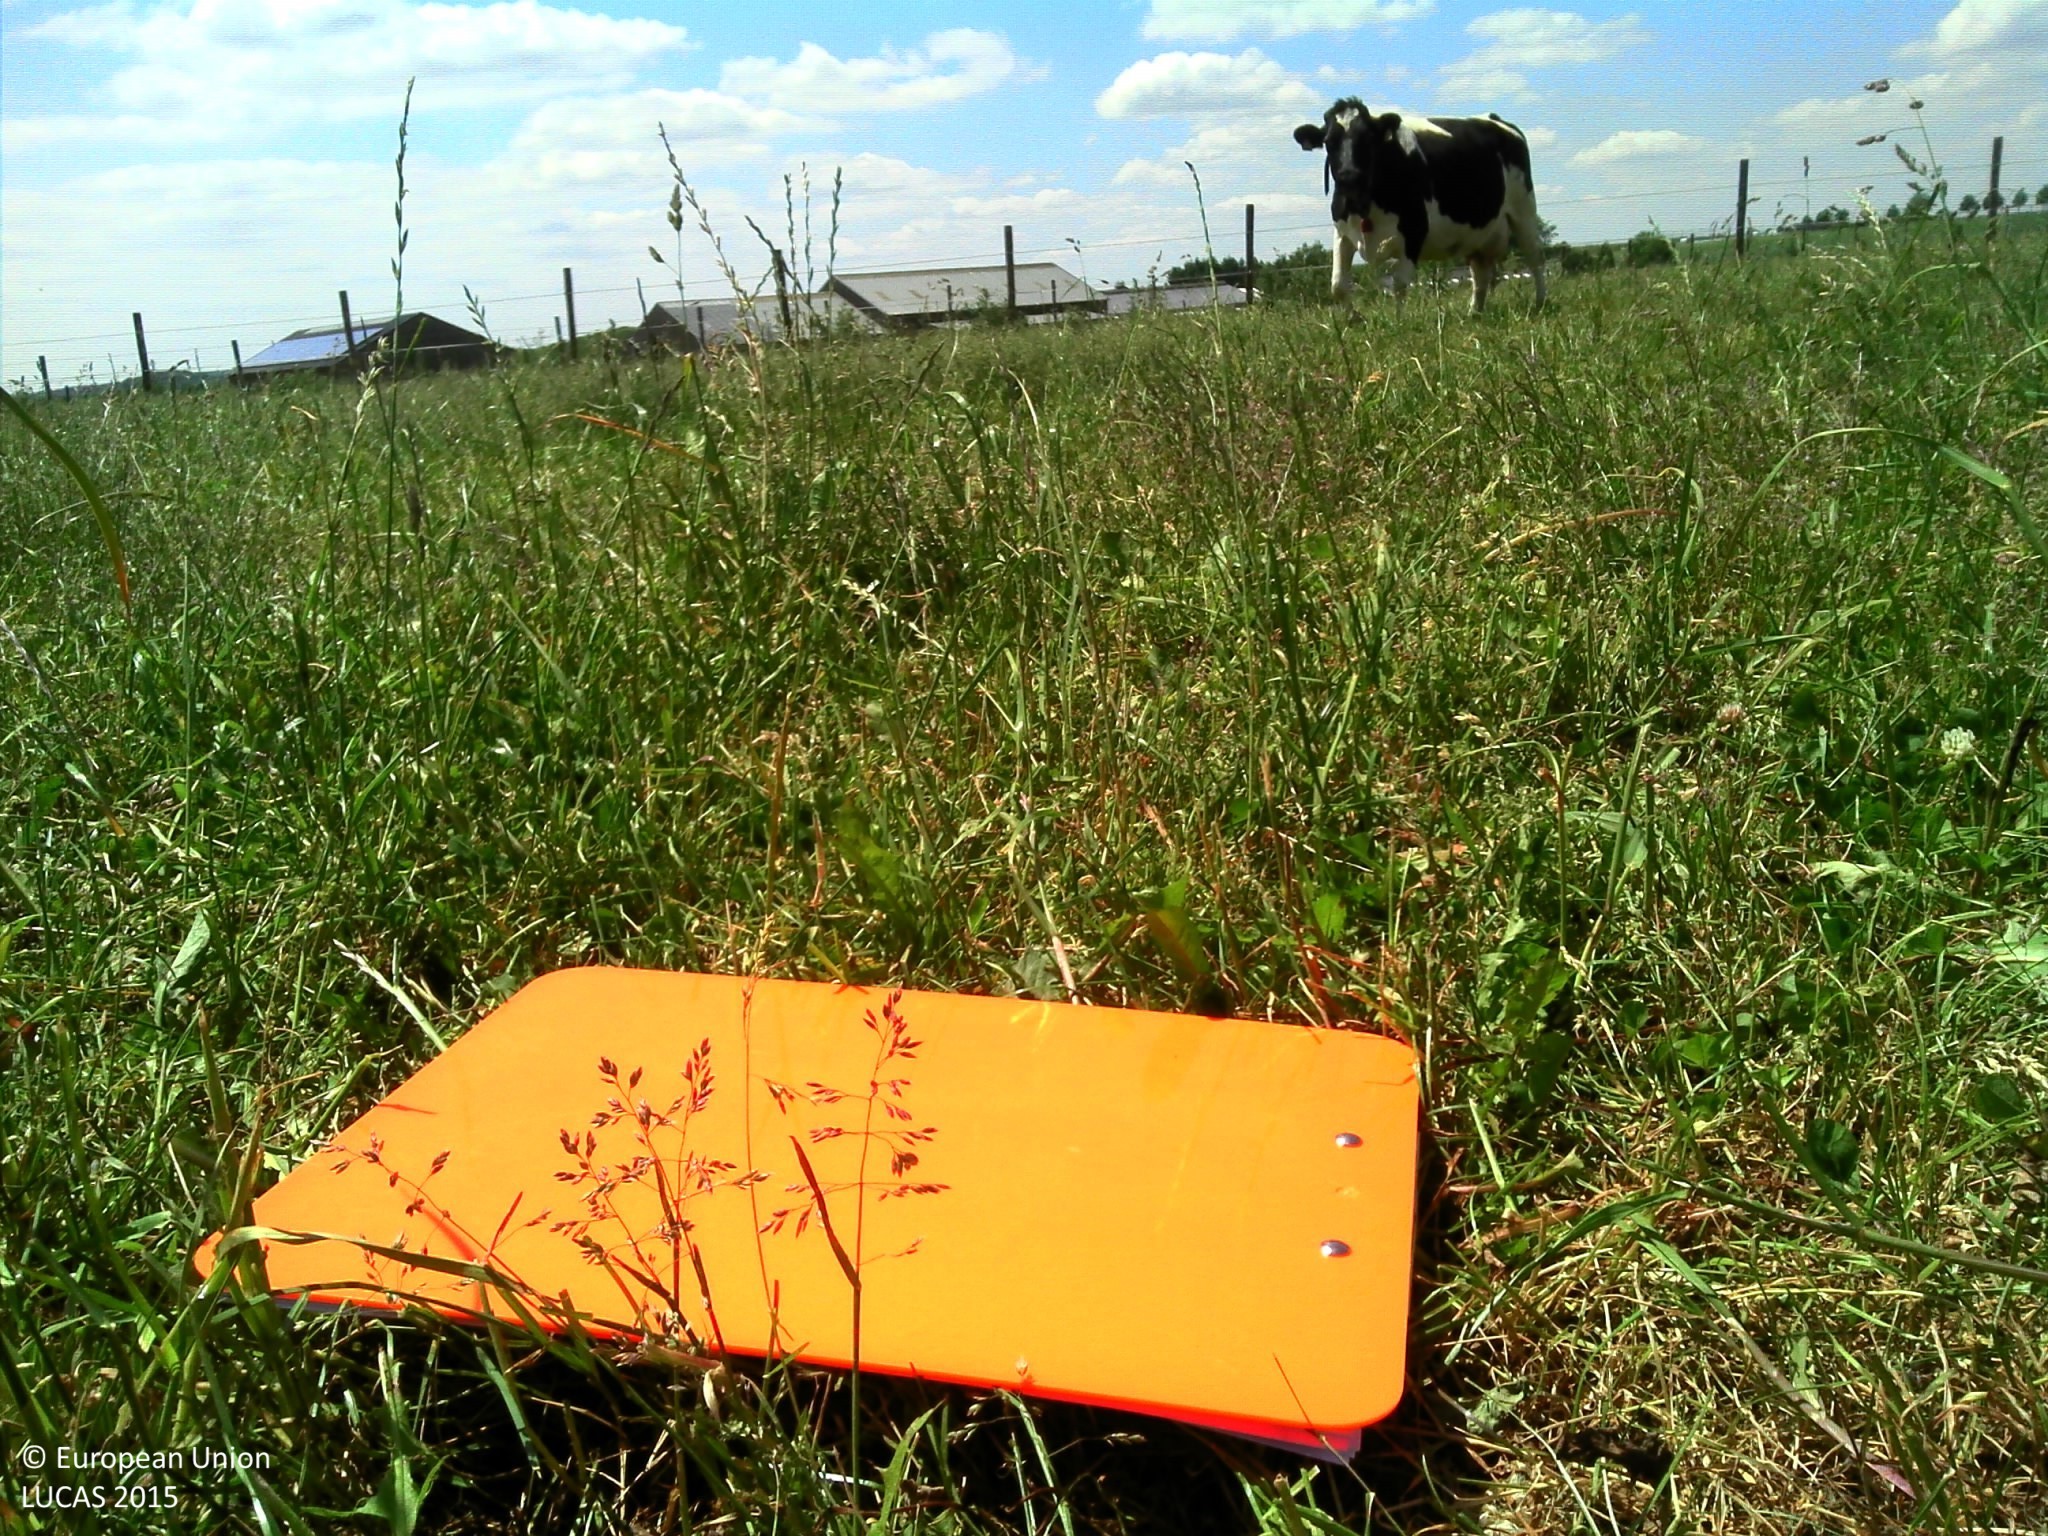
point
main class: Grassland
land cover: Grassland without tree/shrub cover
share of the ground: > 75 %
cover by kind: herbaceous plants 100 %
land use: Agriculture (excluding fallow land and kitchen gardens)
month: June
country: LU
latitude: 49.8783
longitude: 5.9496
